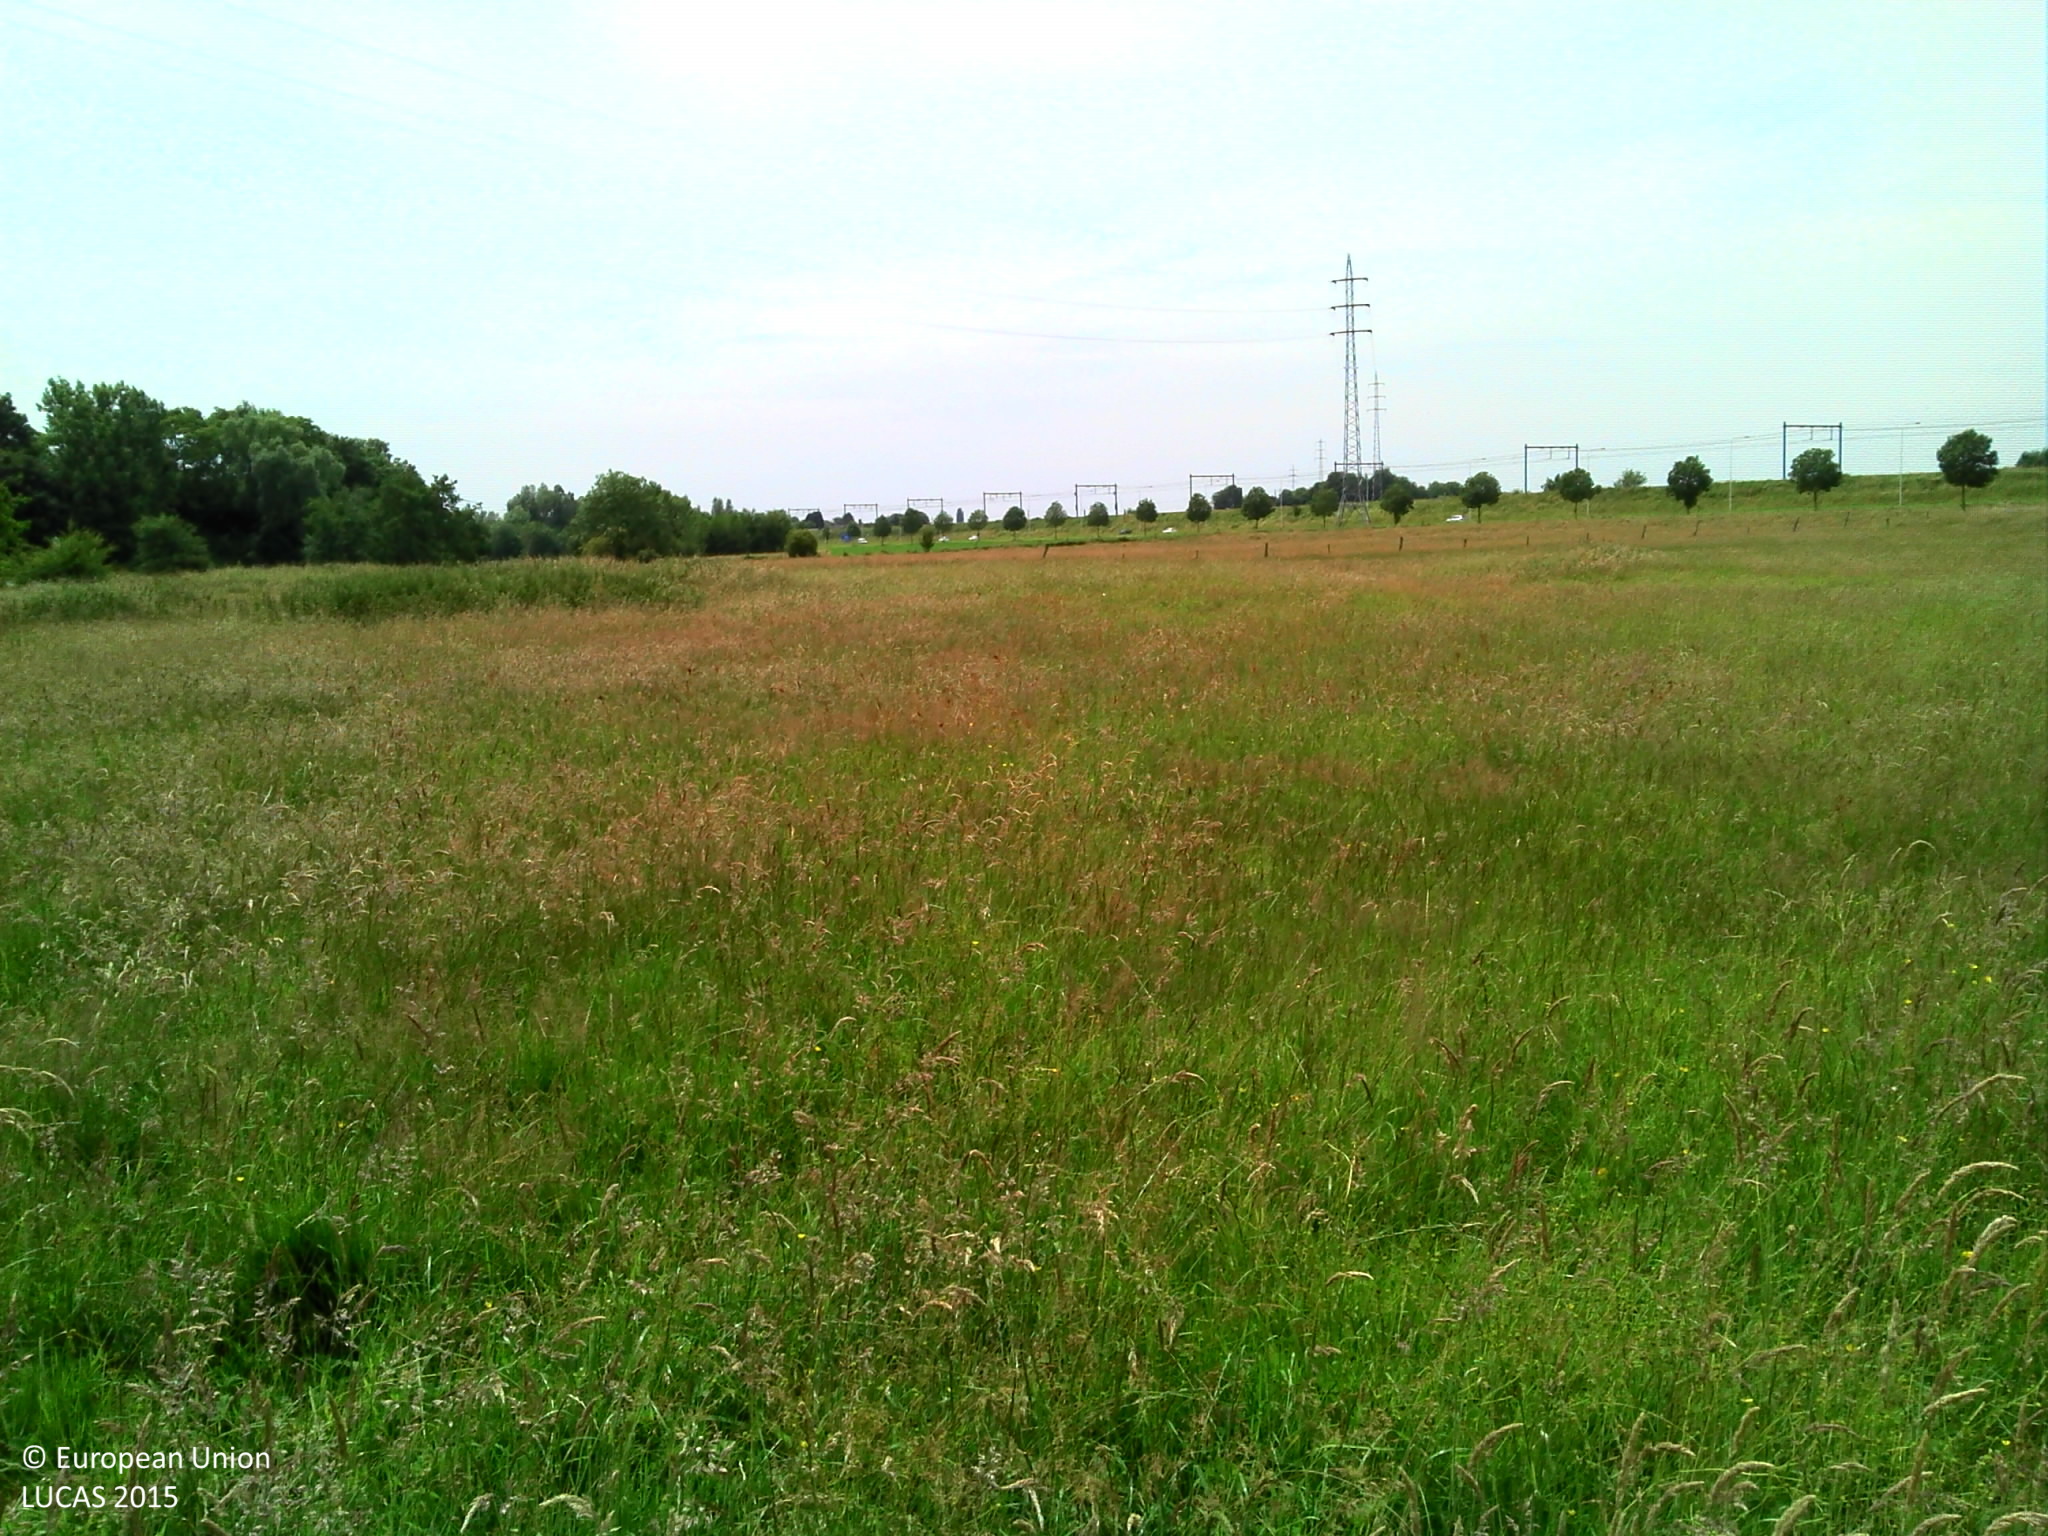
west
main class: Grassland
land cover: Grassland without tree/shrub cover
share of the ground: > 75 %
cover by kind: herbaceous plants 100 %
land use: Agriculture (excluding fallow land and kitchen gardens)
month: June
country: BE
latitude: 50.6459
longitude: 3.7850
